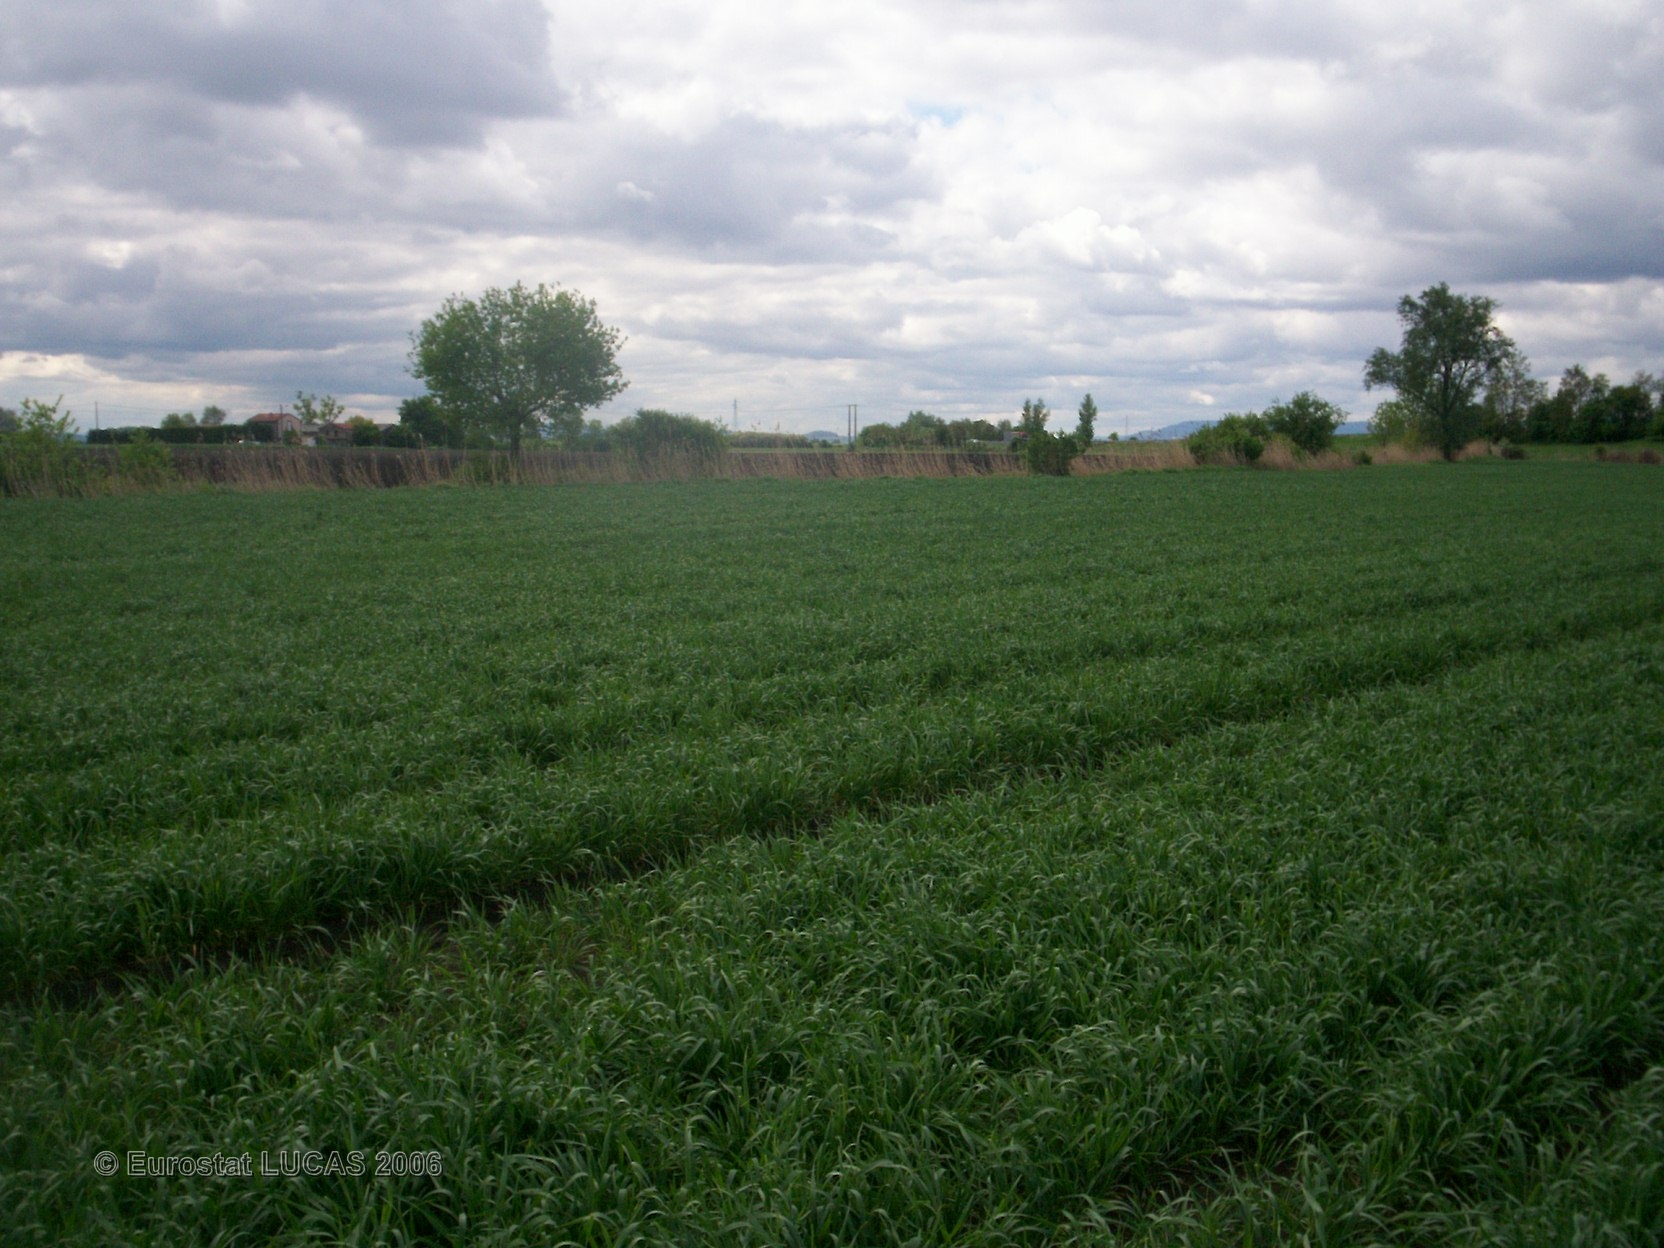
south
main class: Cropland
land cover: Barley
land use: Agriculture (excluding fallow land and kitchen gardens)
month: May
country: FR
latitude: 45.9148
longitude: 3.1535
